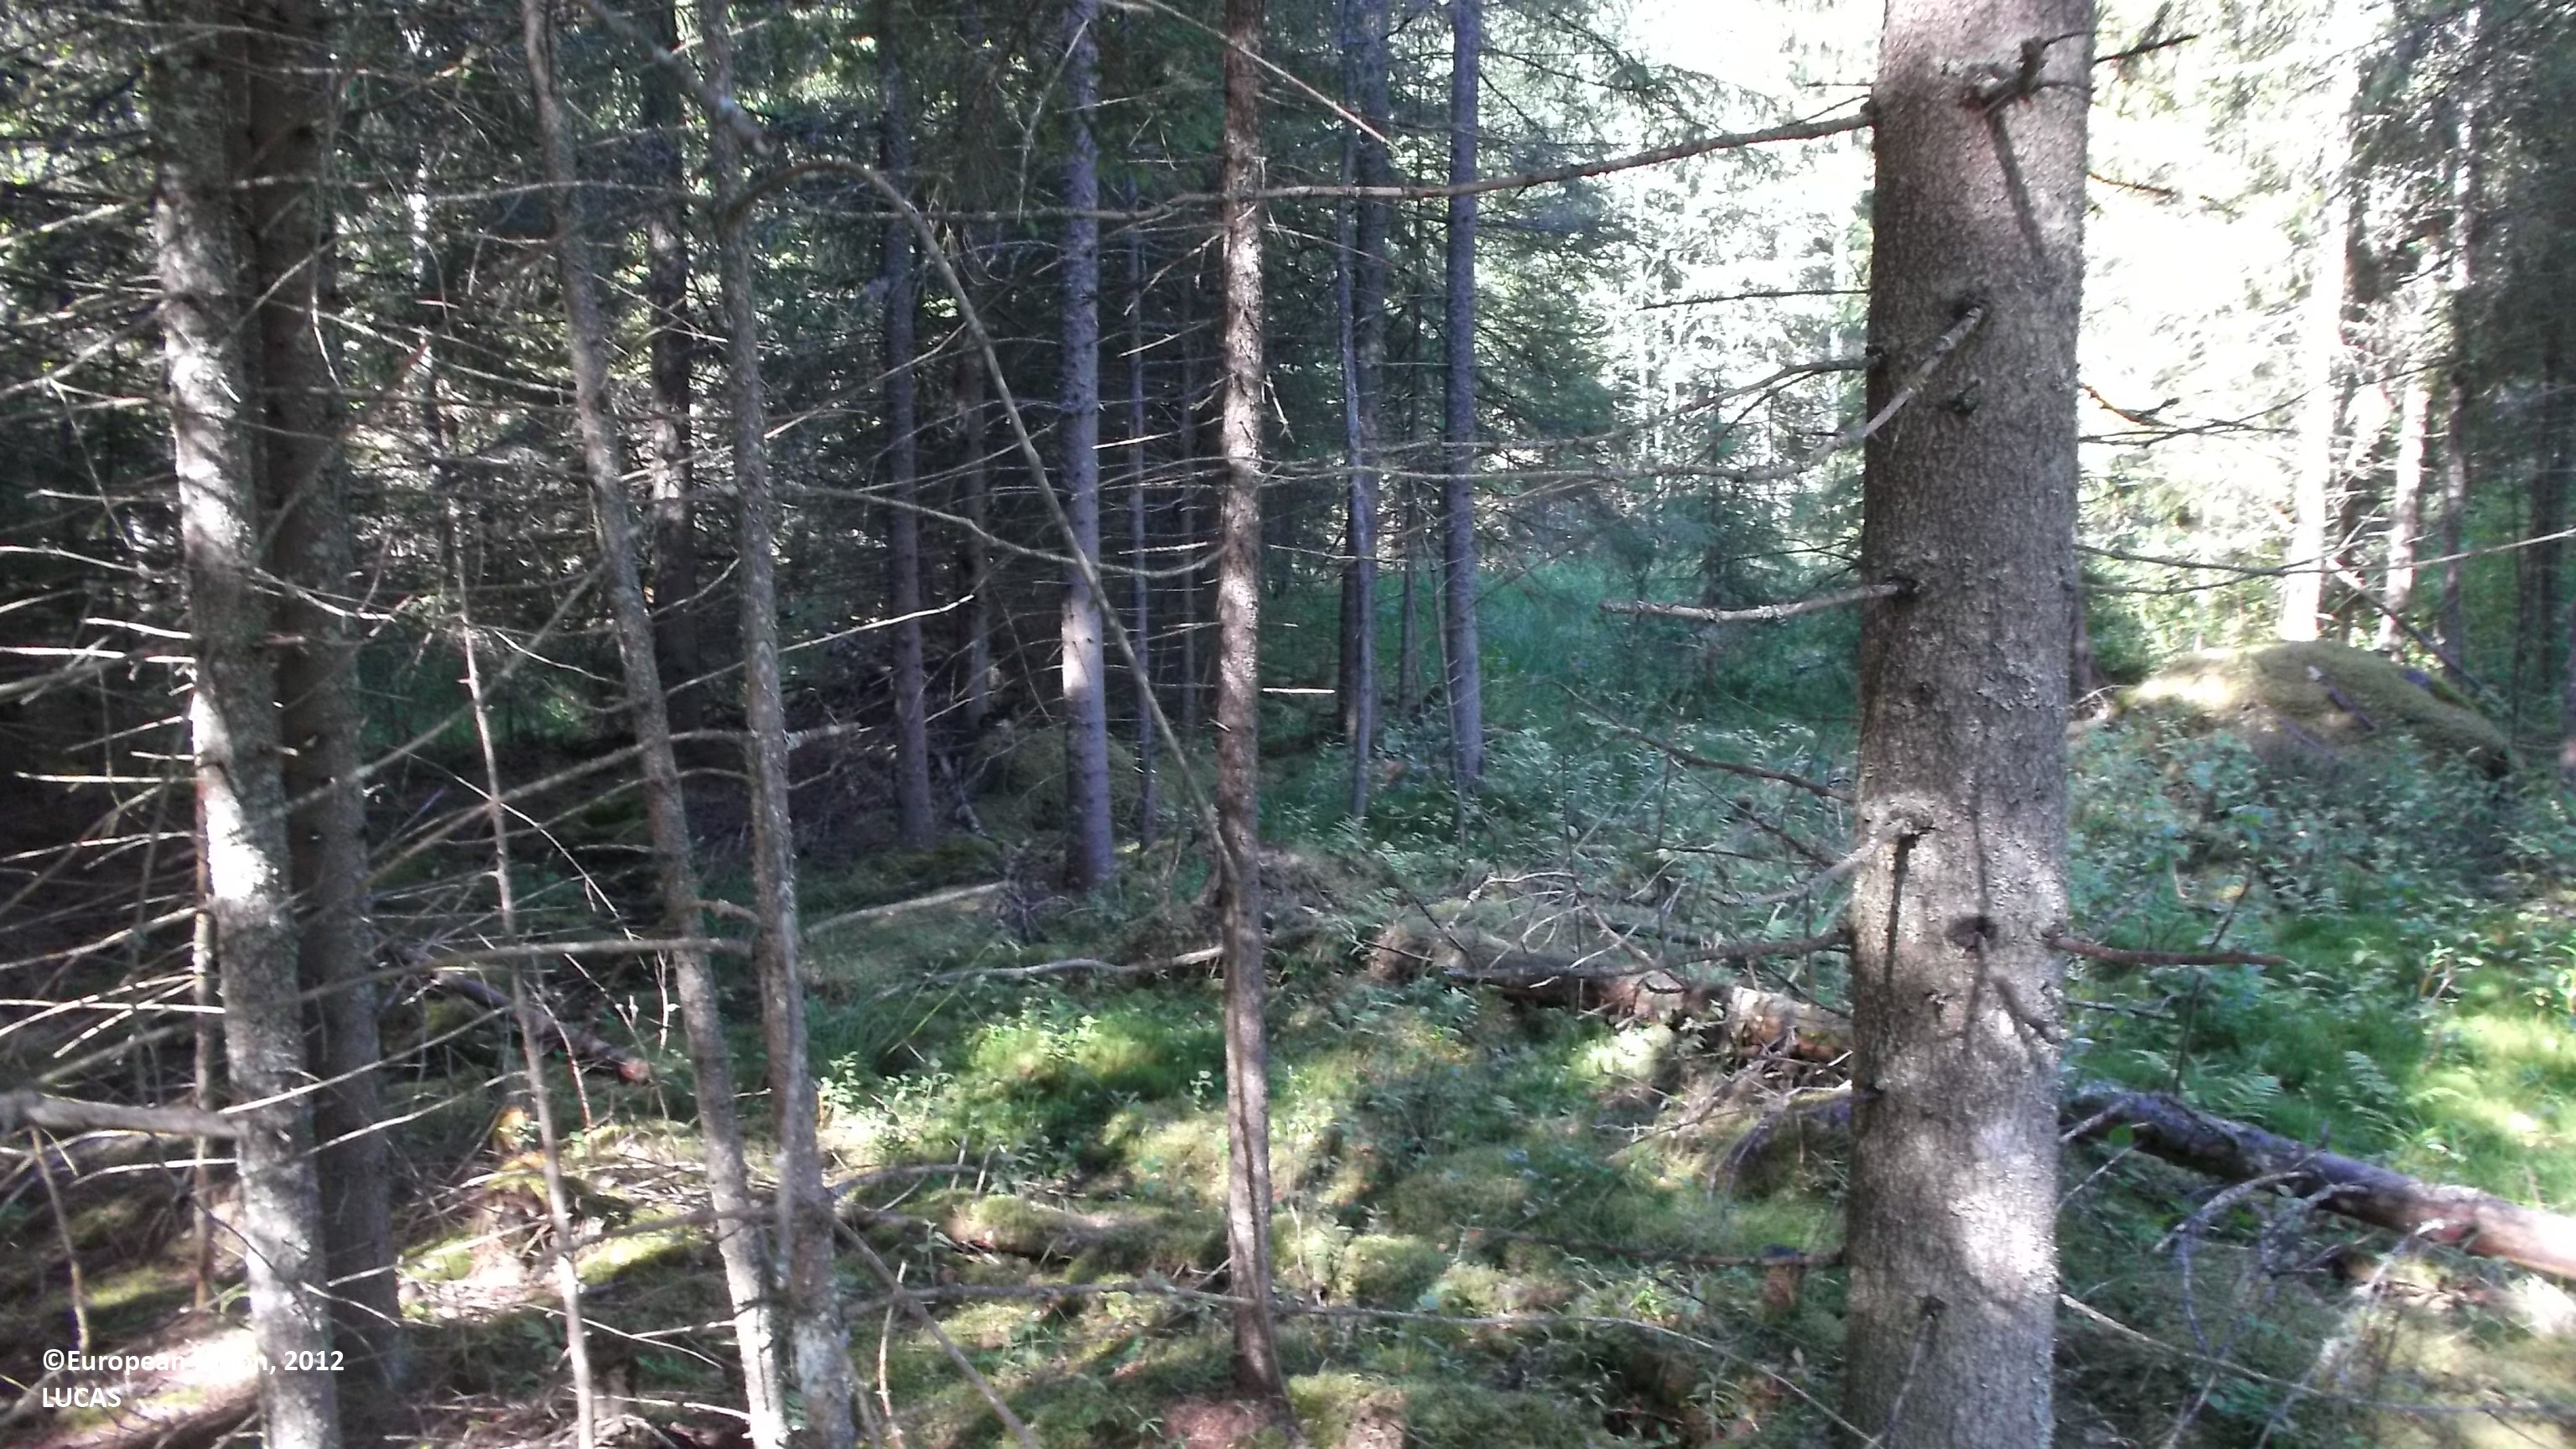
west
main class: Woodland
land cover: Spruce dominated coniferous woodland
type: boreal forest
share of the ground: > 75 %
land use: Forestry
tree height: > 5 m
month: July
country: FI
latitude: 63.8608
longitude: 23.2170
